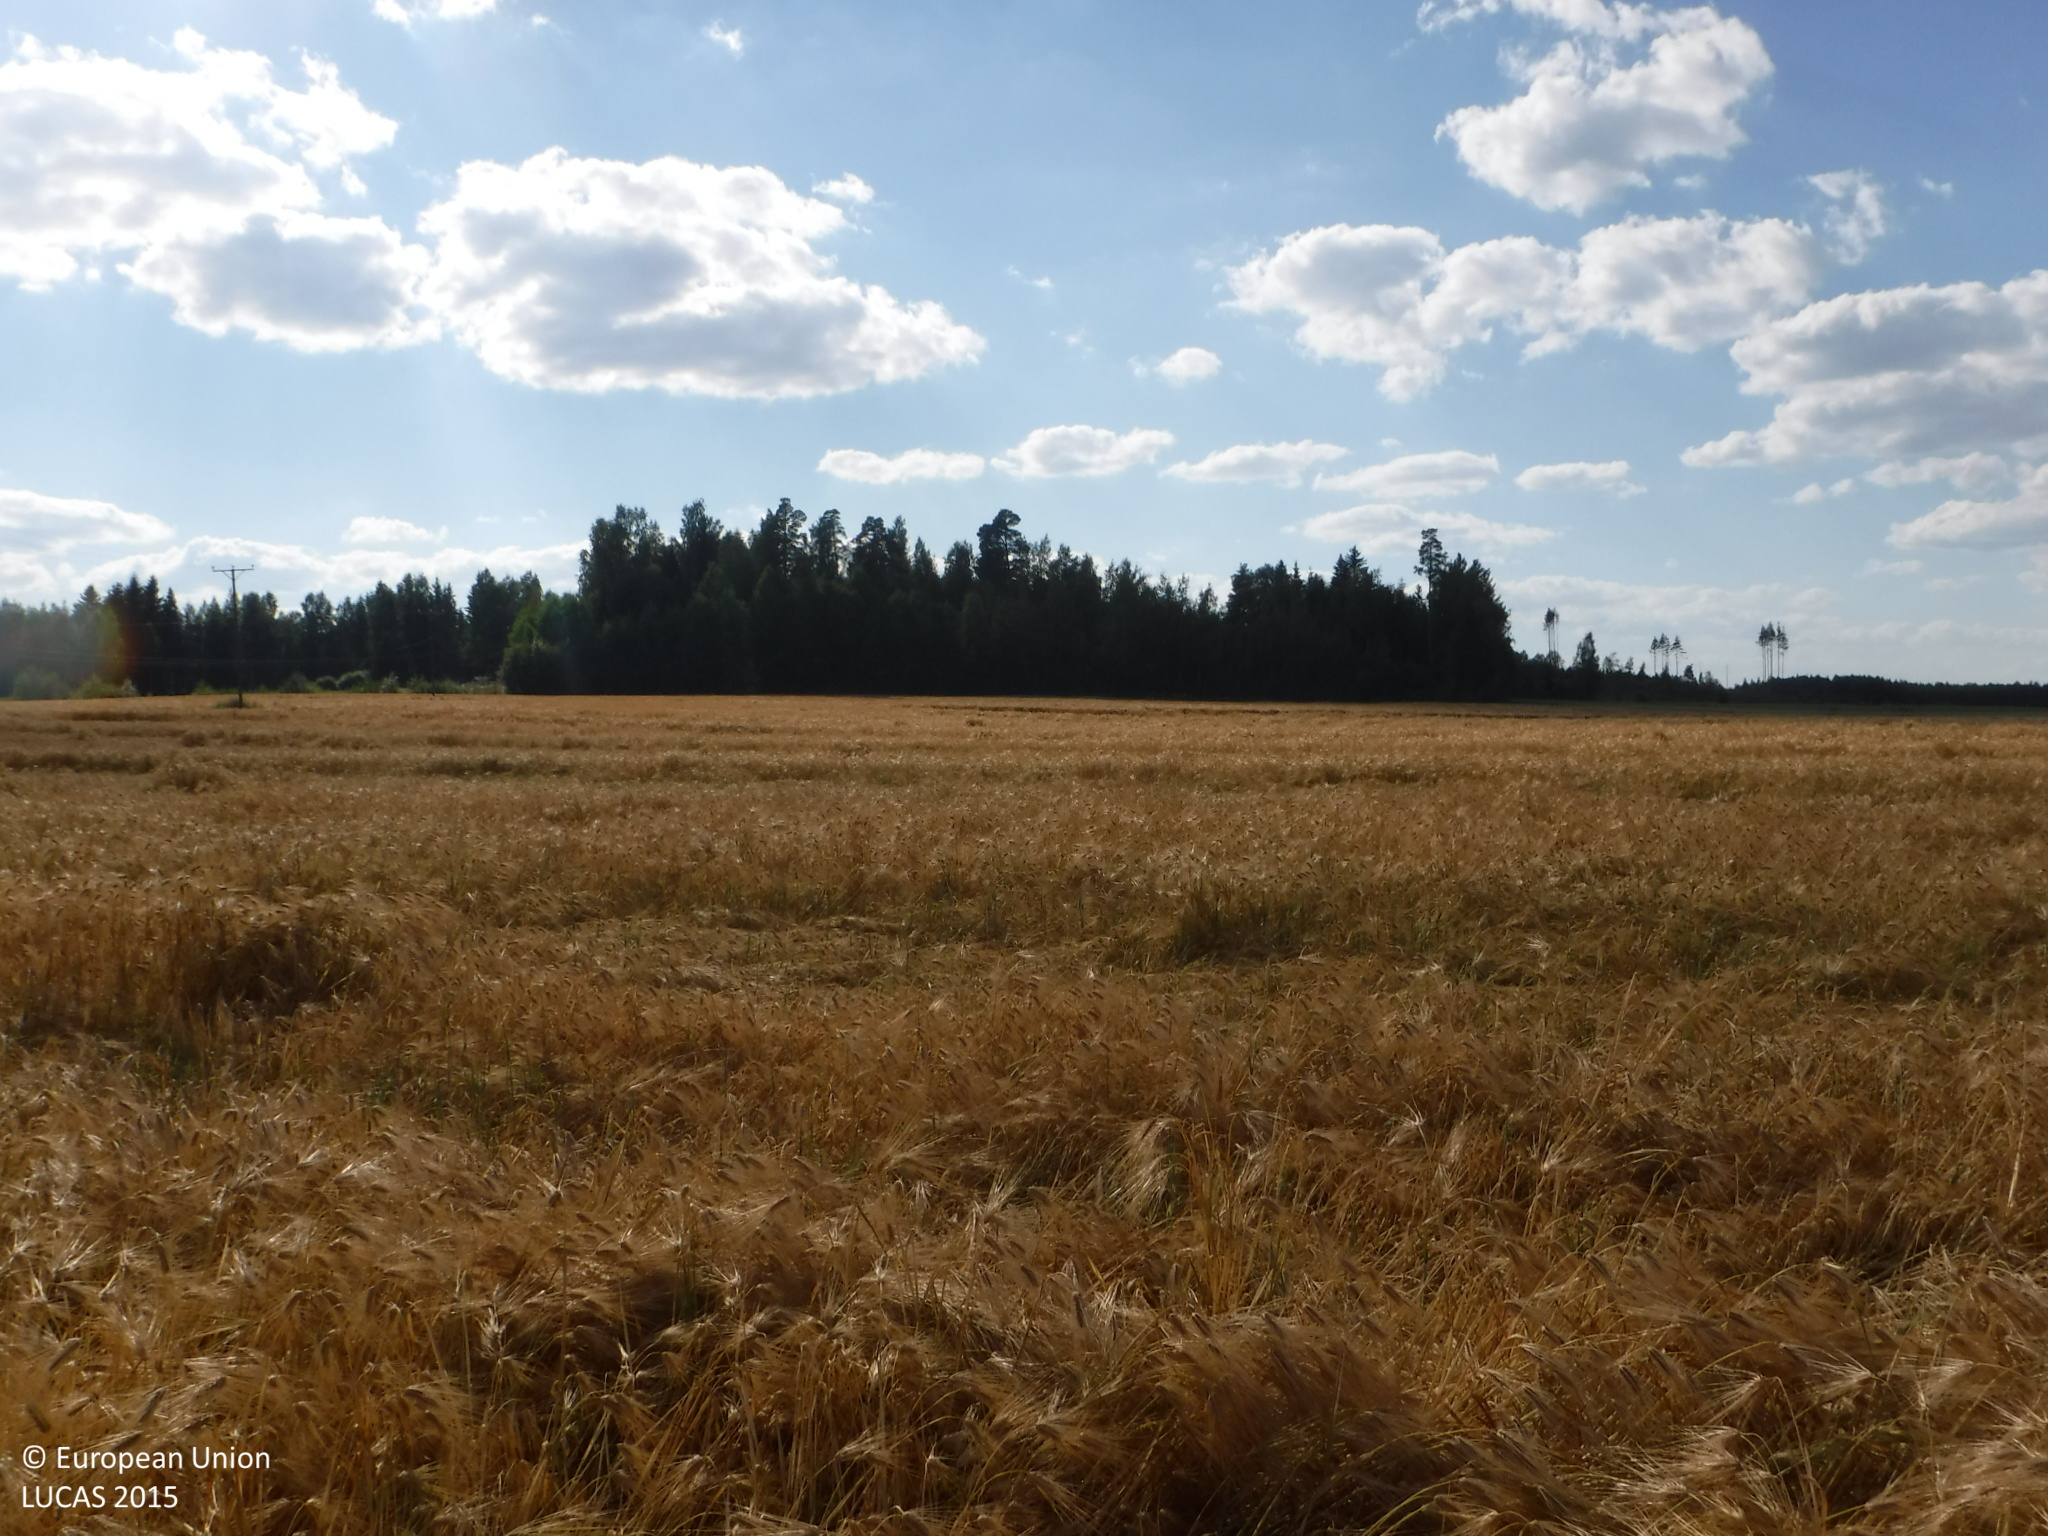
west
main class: Cropland
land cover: Barley
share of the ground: > 75 %
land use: Agriculture (excluding fallow land and kitchen gardens)
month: August
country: FI
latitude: 61.1389
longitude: 22.9054
